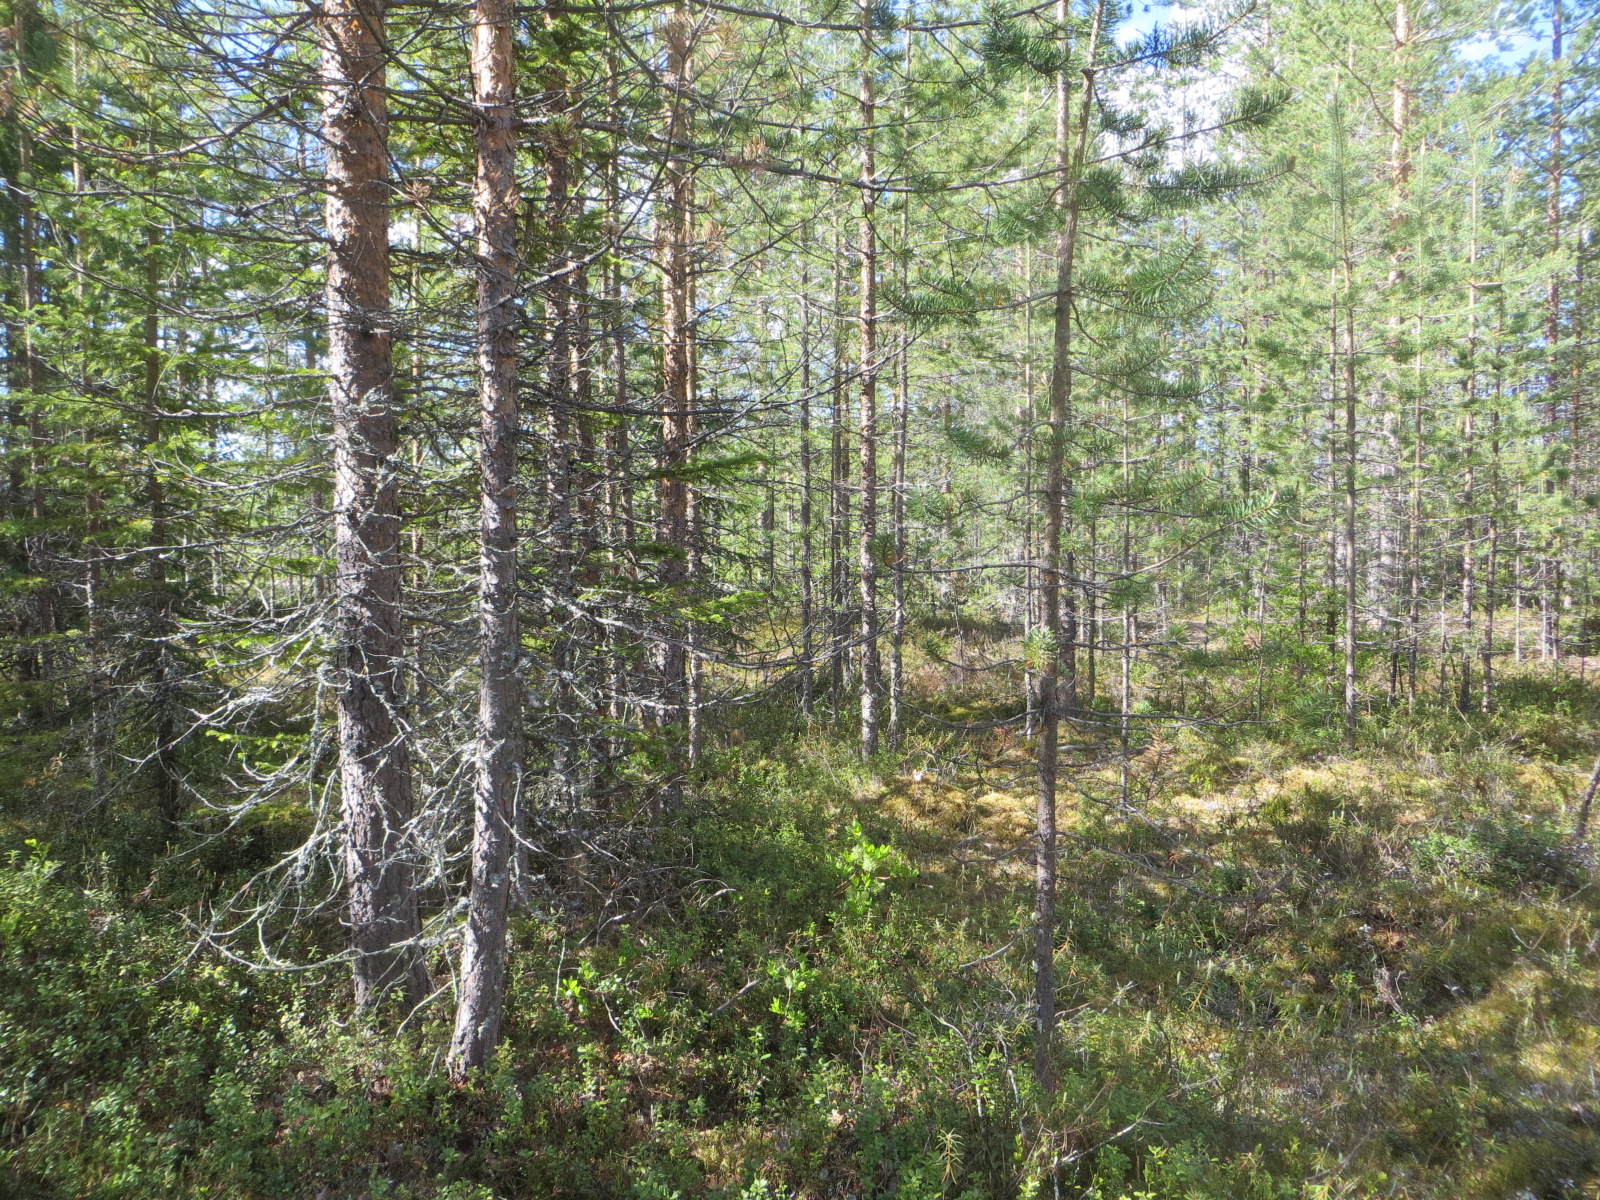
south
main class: Woodland
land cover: Other mixed woodland
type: boreal forest
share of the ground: > 75 %
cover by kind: coniferous forest trees 50 %, broadleaved forest trees 30 %, shrubs 20 %
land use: Forestry
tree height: > 5 m
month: June
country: FI
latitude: 66.9170
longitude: 25.3925
